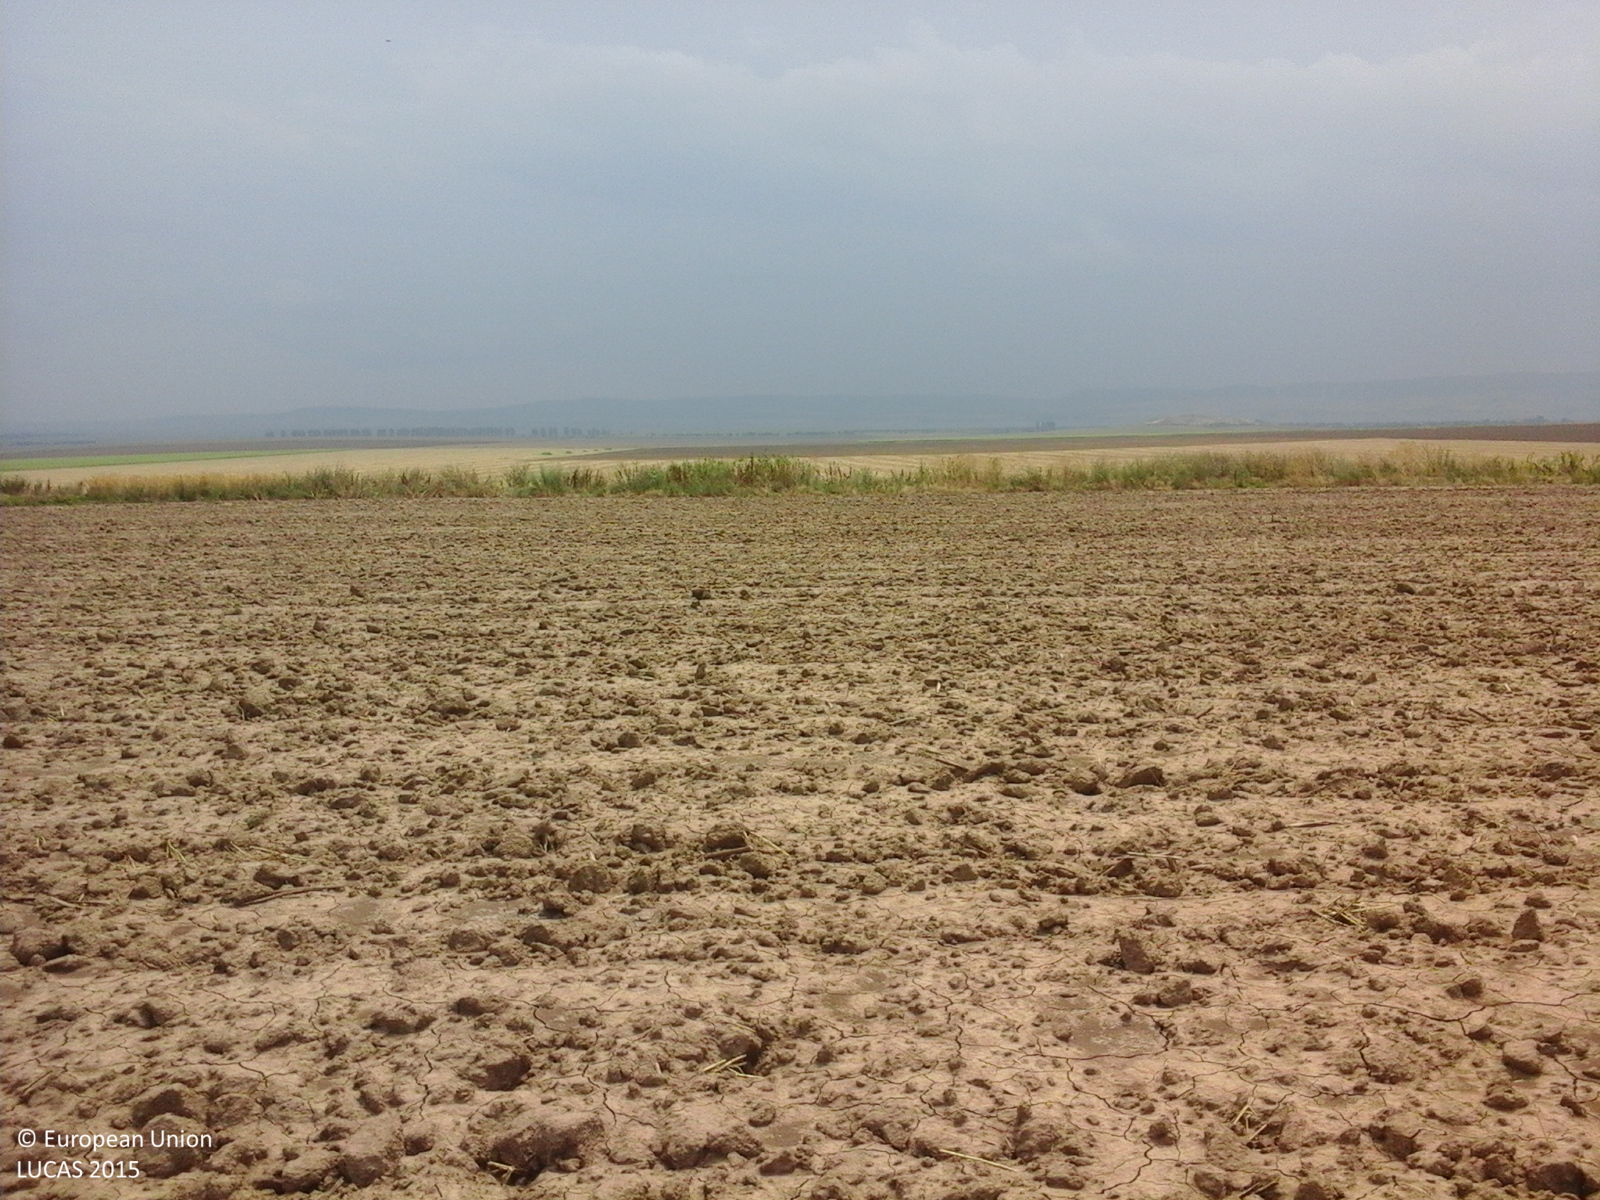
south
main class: Cropland
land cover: Common wheat
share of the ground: < 10 %
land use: Agriculture (excluding fallow land and kitchen gardens)
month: July
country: RO
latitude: 44.9798
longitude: 28.7929
